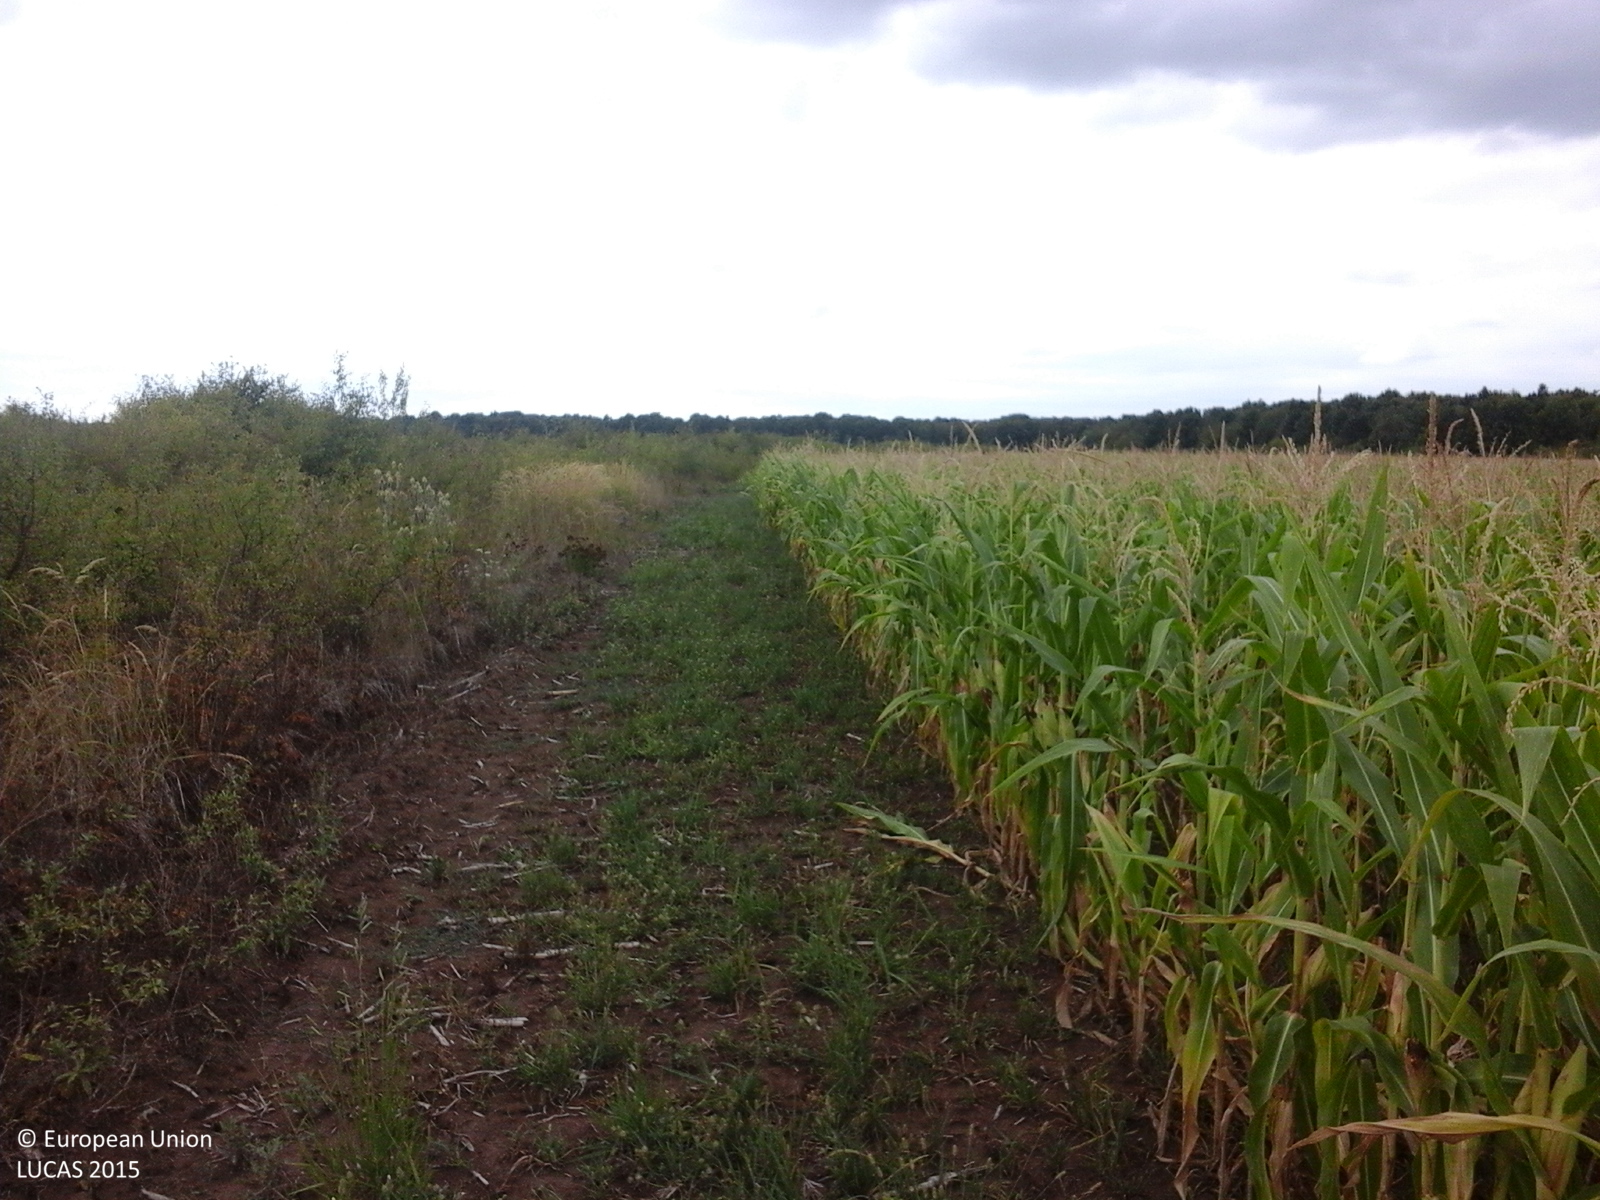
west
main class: Cropland
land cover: Maize
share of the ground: > 75 %
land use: Agriculture (excluding fallow land and kitchen gardens)
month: August
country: RO
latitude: 45.4378
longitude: 21.4988
